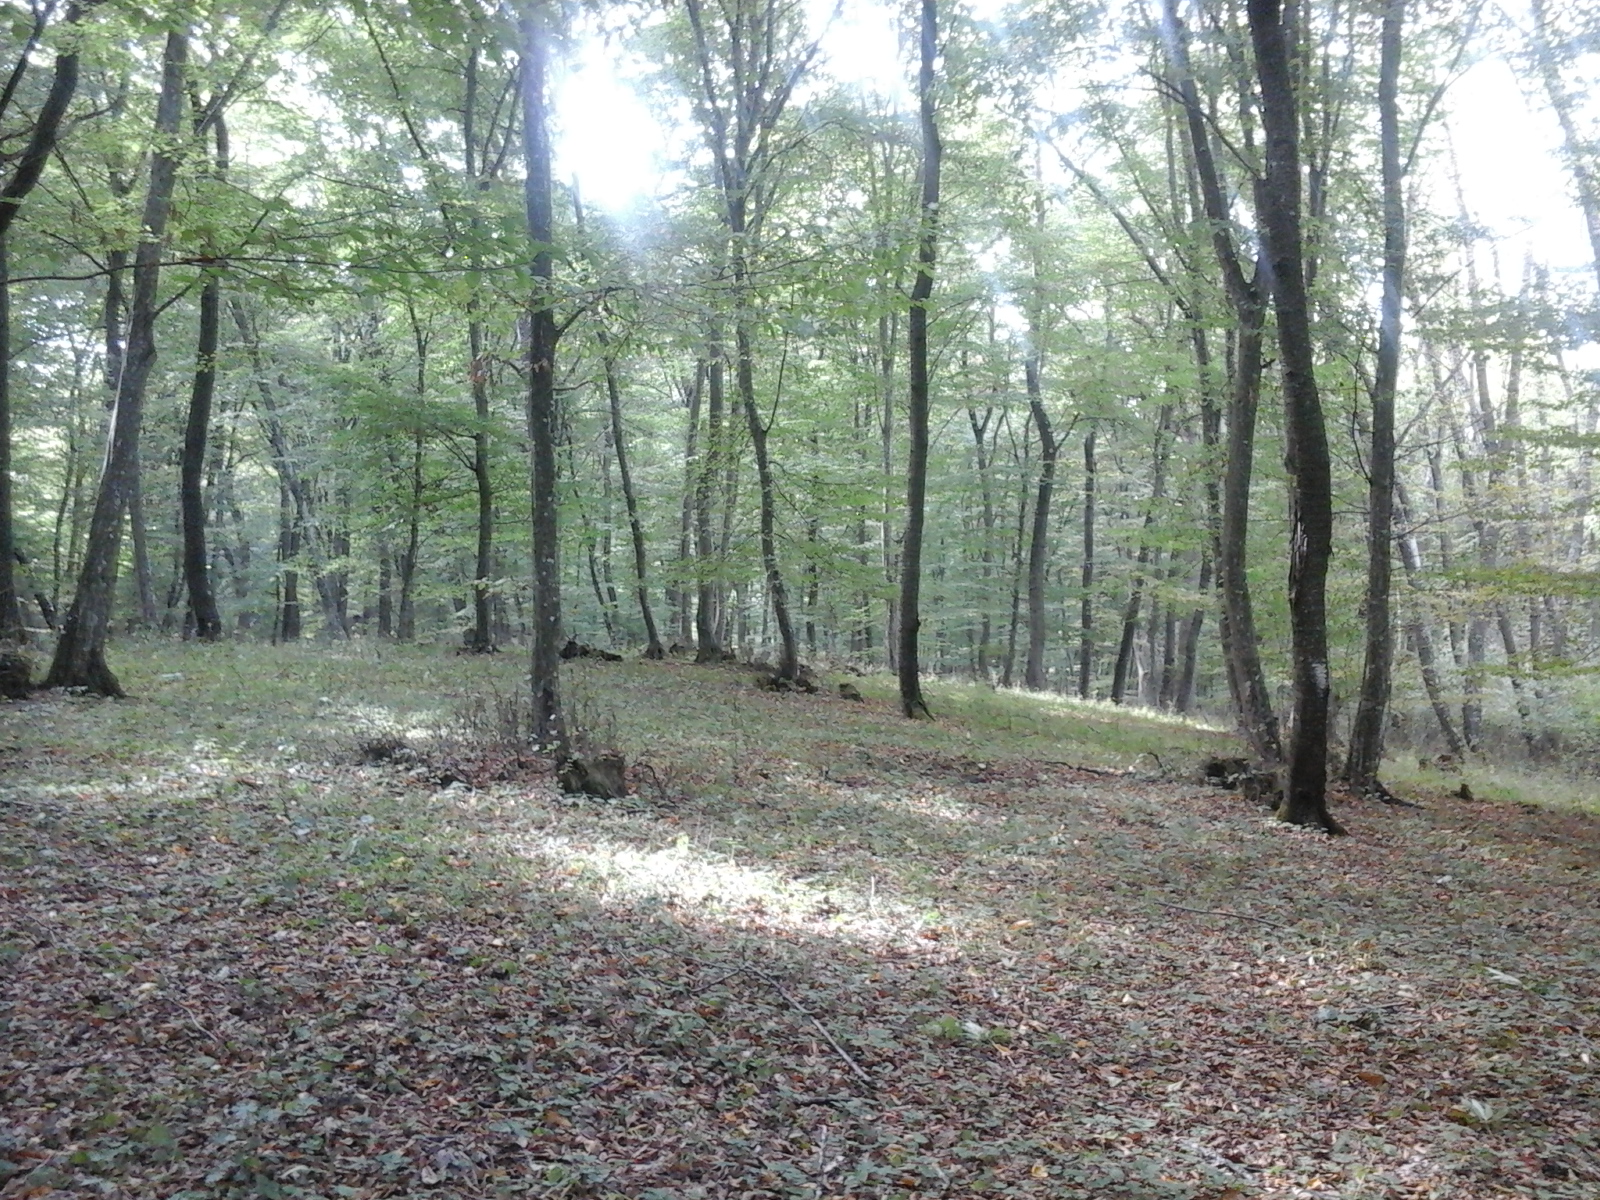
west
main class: Woodland
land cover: Broadleaved woodland
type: mesophytic deciduous forest
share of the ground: > 75 %
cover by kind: broadleaved forest trees 100 %
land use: Forestry
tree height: > 5 m
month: September
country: RO
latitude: 46.9286
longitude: 24.0952
